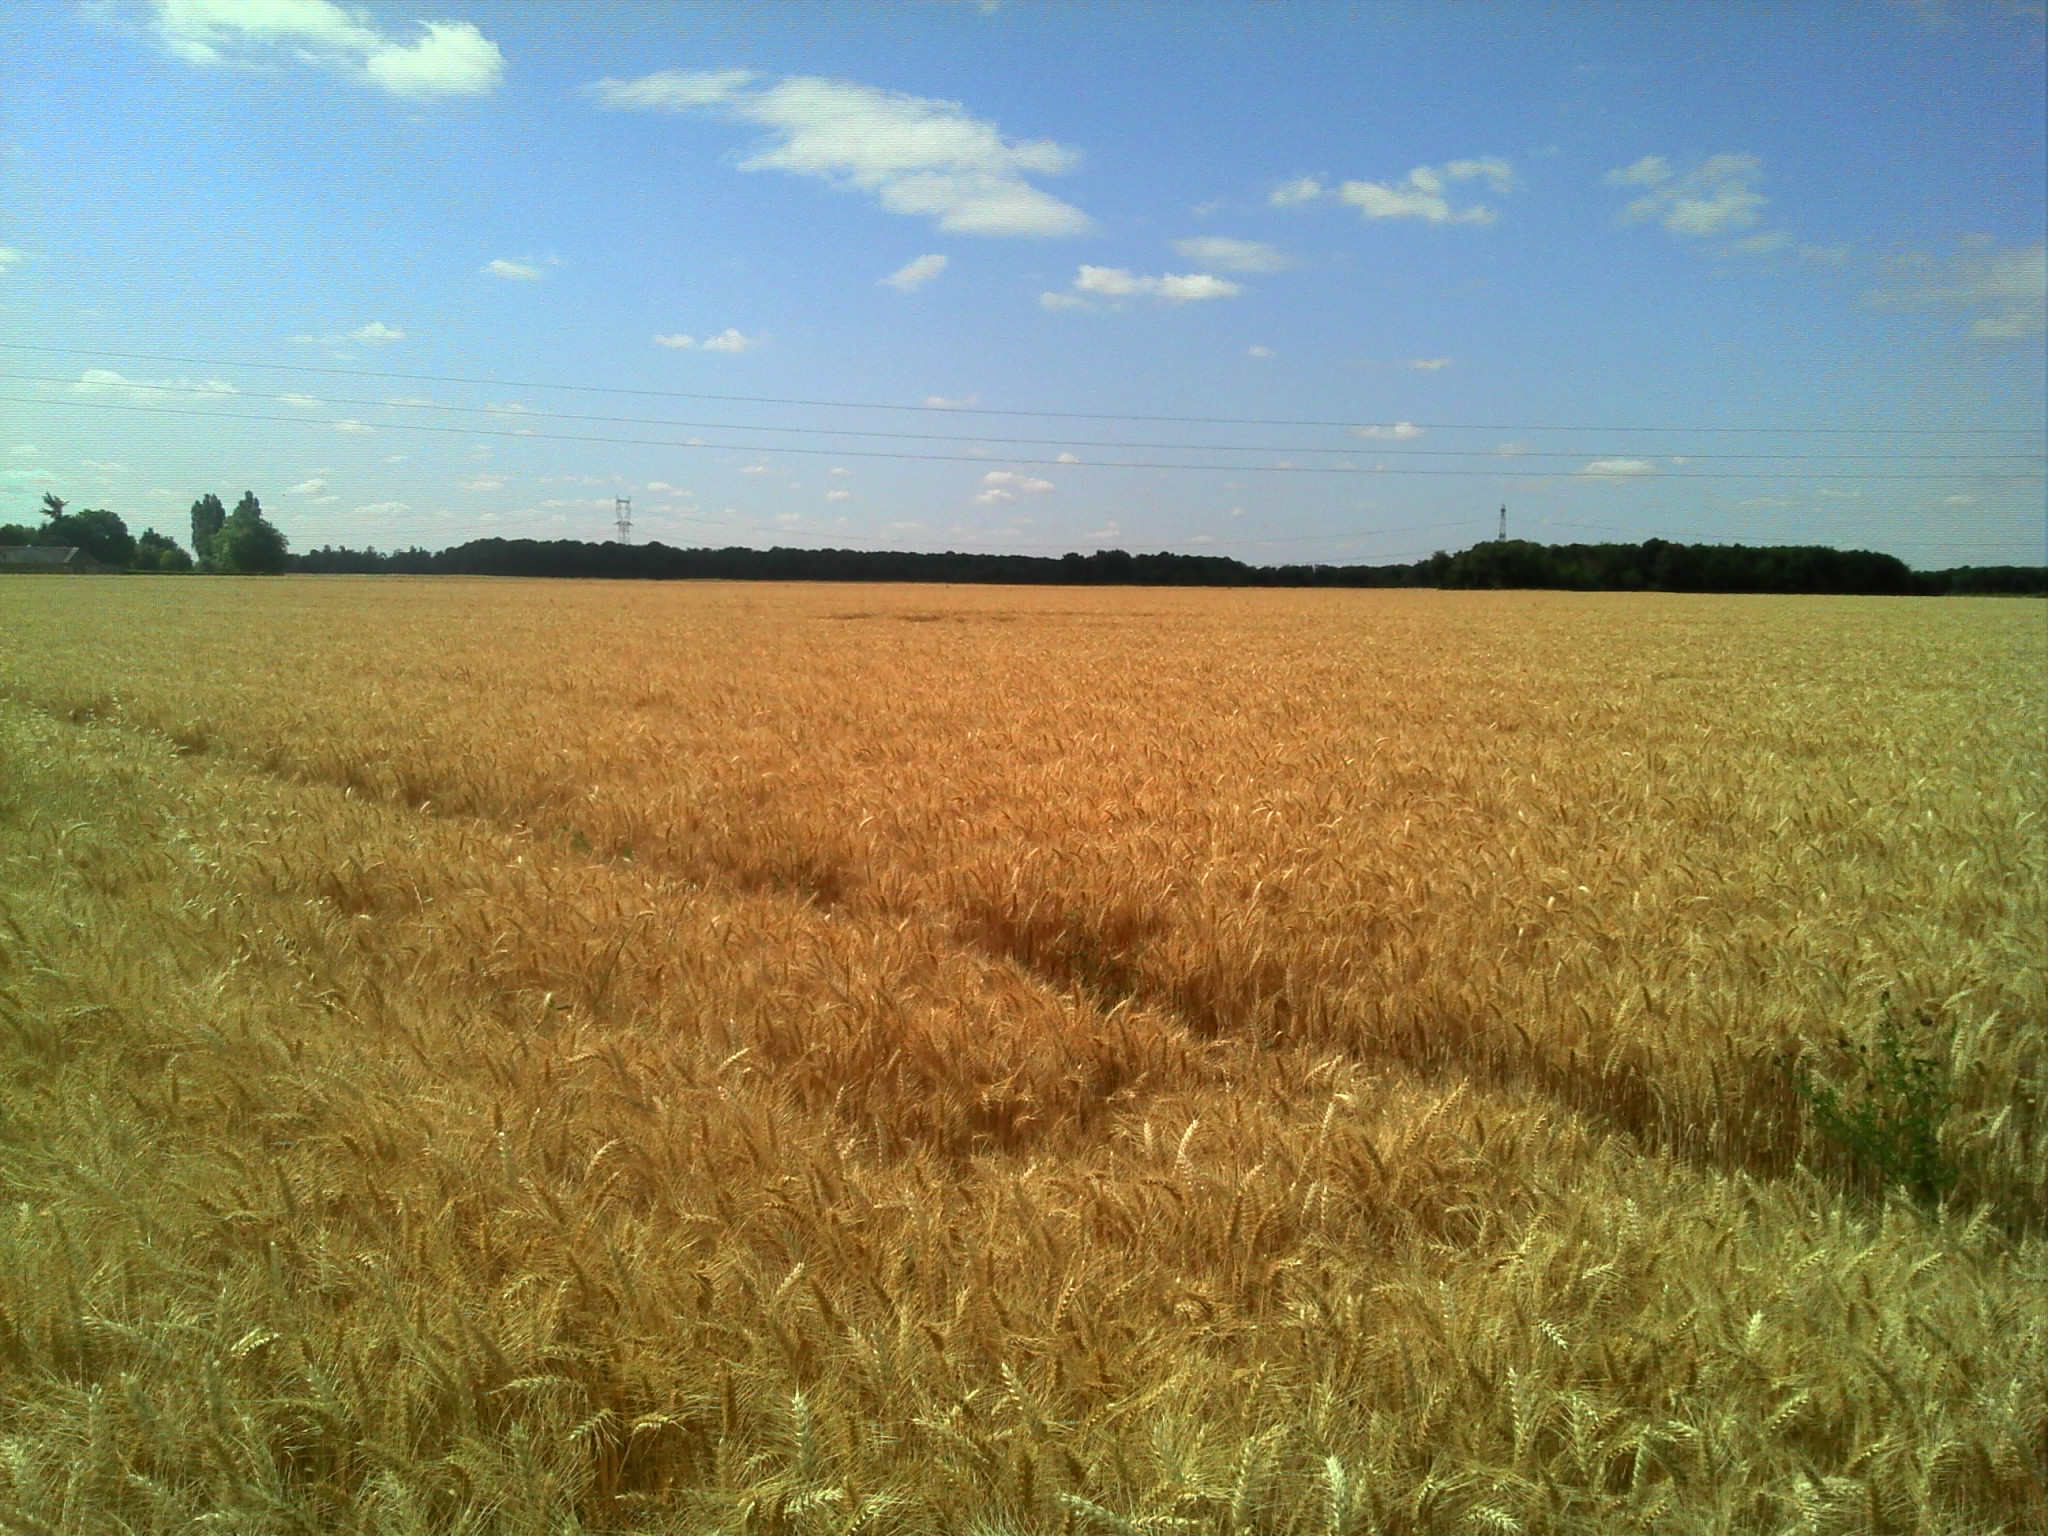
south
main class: Cropland
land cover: Common wheat
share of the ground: > 75 %
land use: Agriculture (excluding fallow land and kitchen gardens)
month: July
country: FR
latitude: 48.8790
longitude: 1.1300
